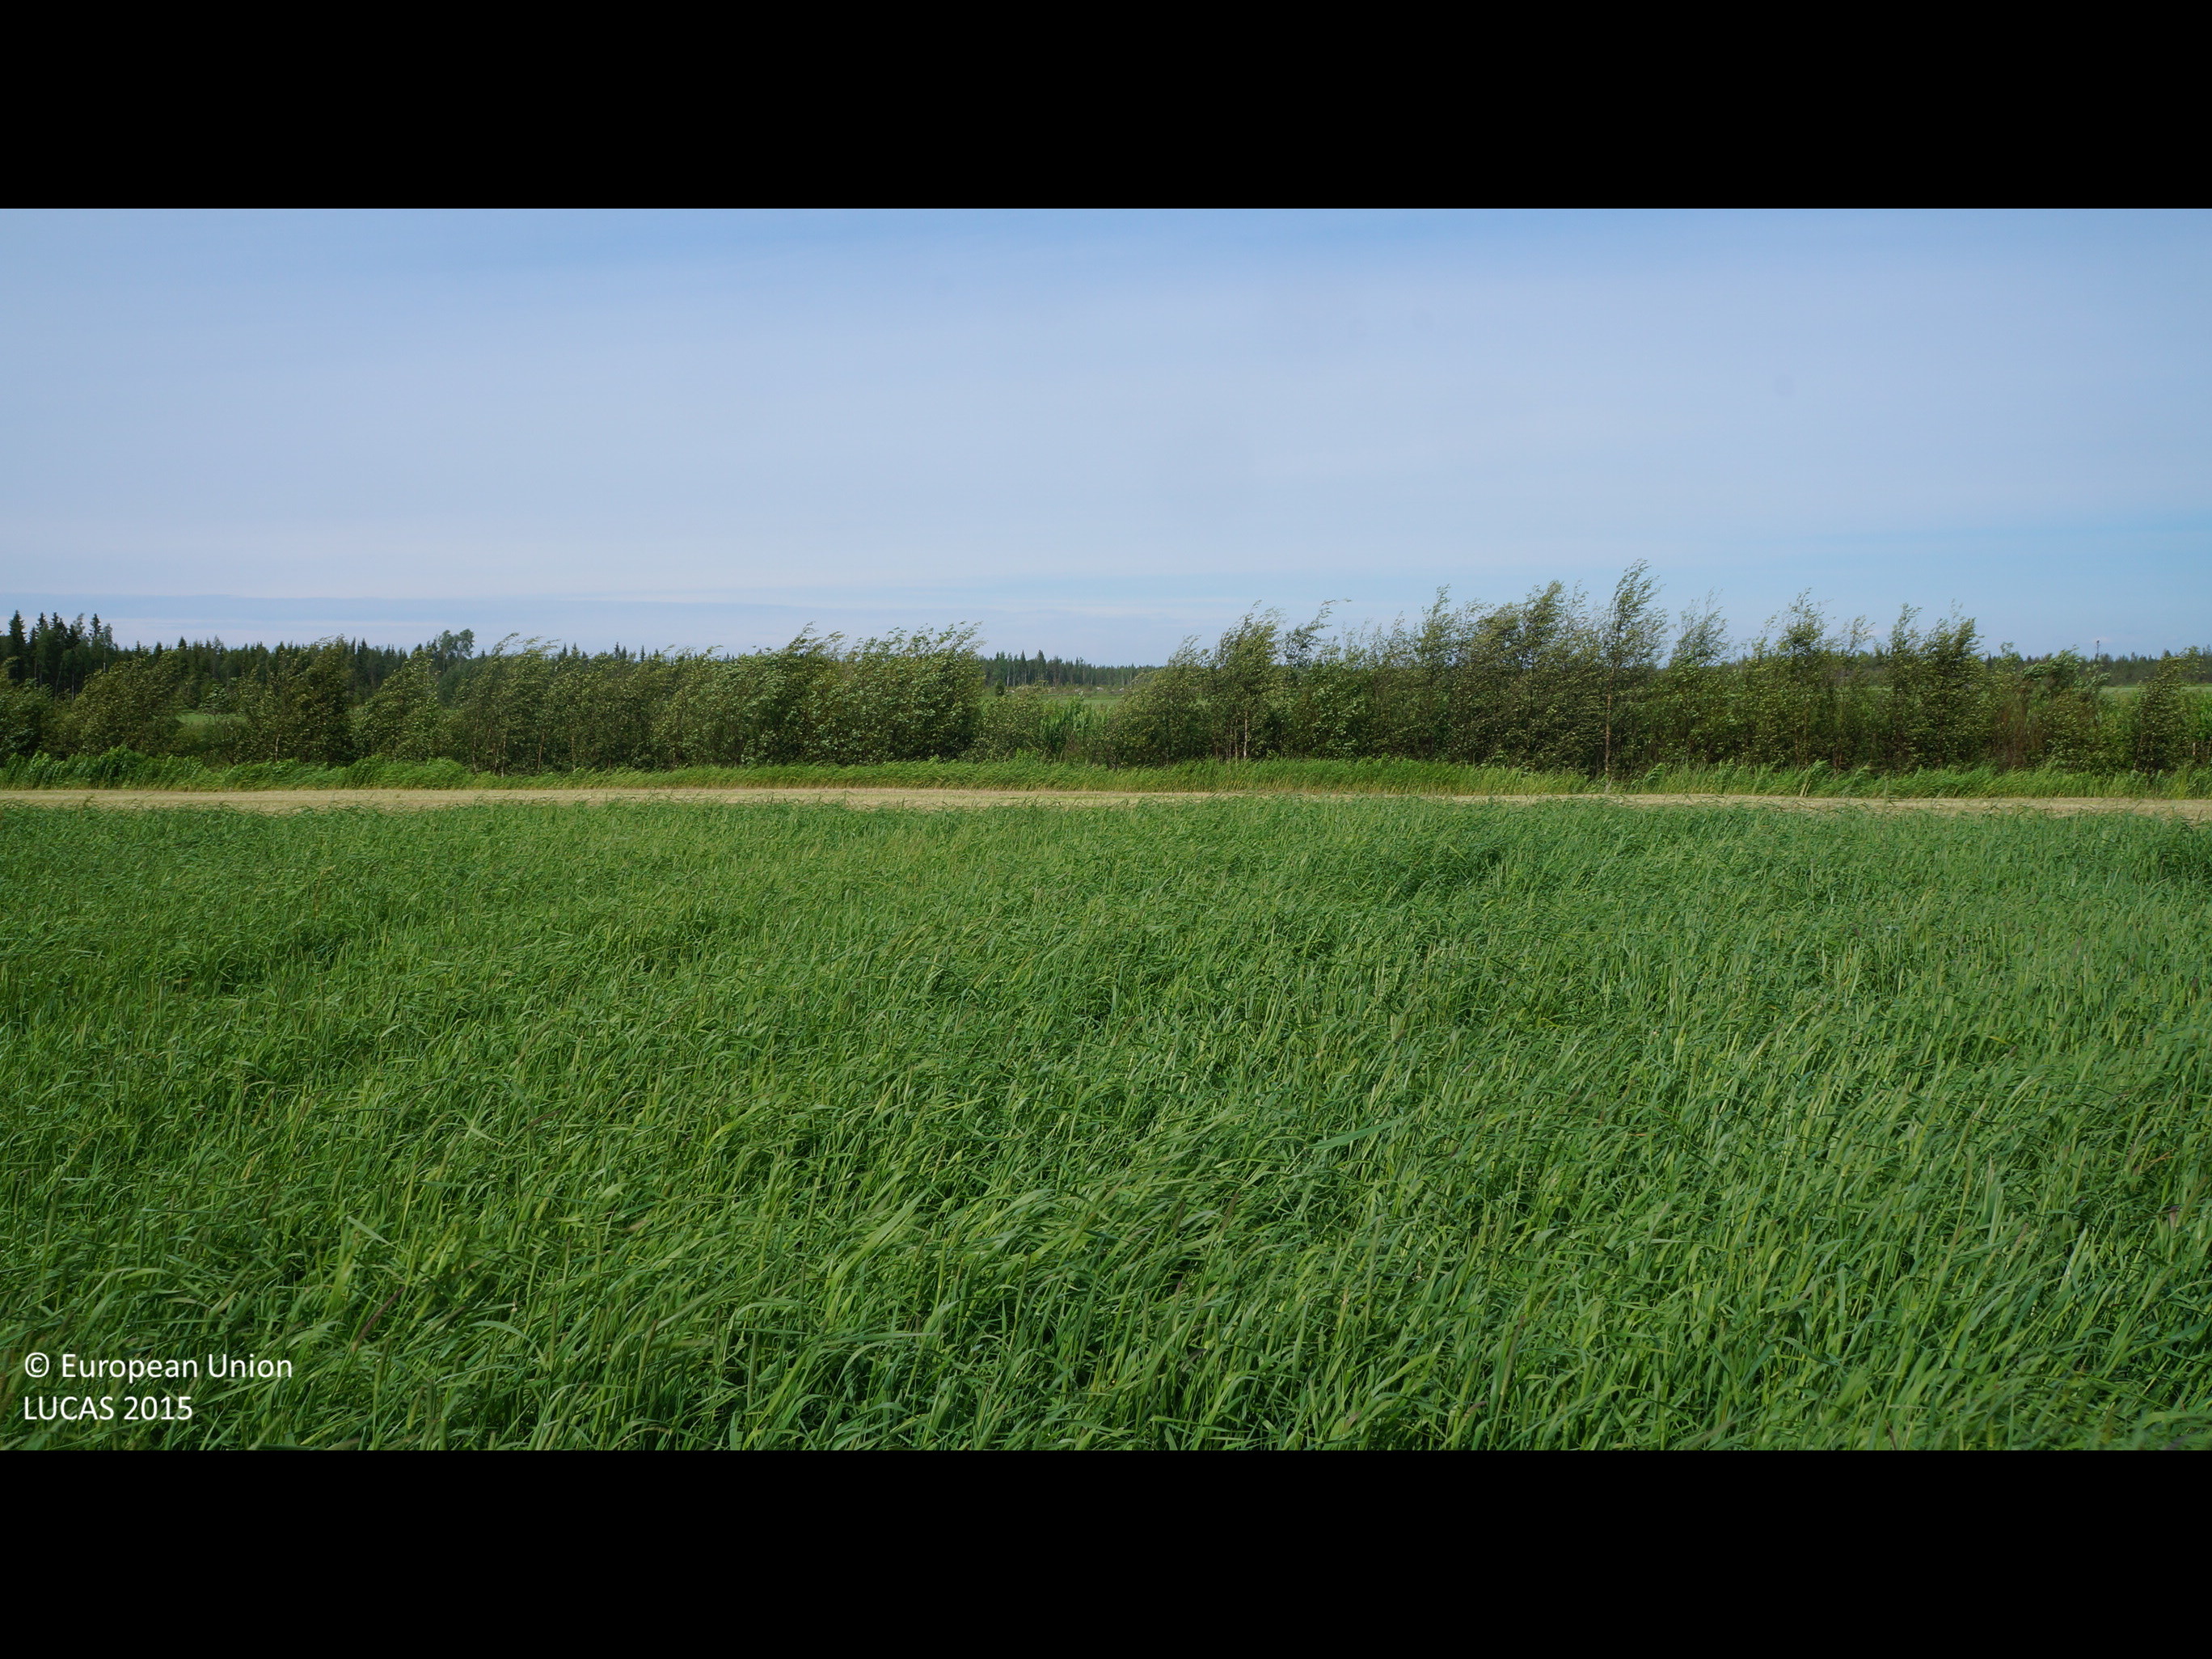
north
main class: Cropland
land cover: Temporary grasslands
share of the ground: > 75 %
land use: Agriculture (excluding fallow land and kitchen gardens)
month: June
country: FI
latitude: 64.1861
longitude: 23.9142
